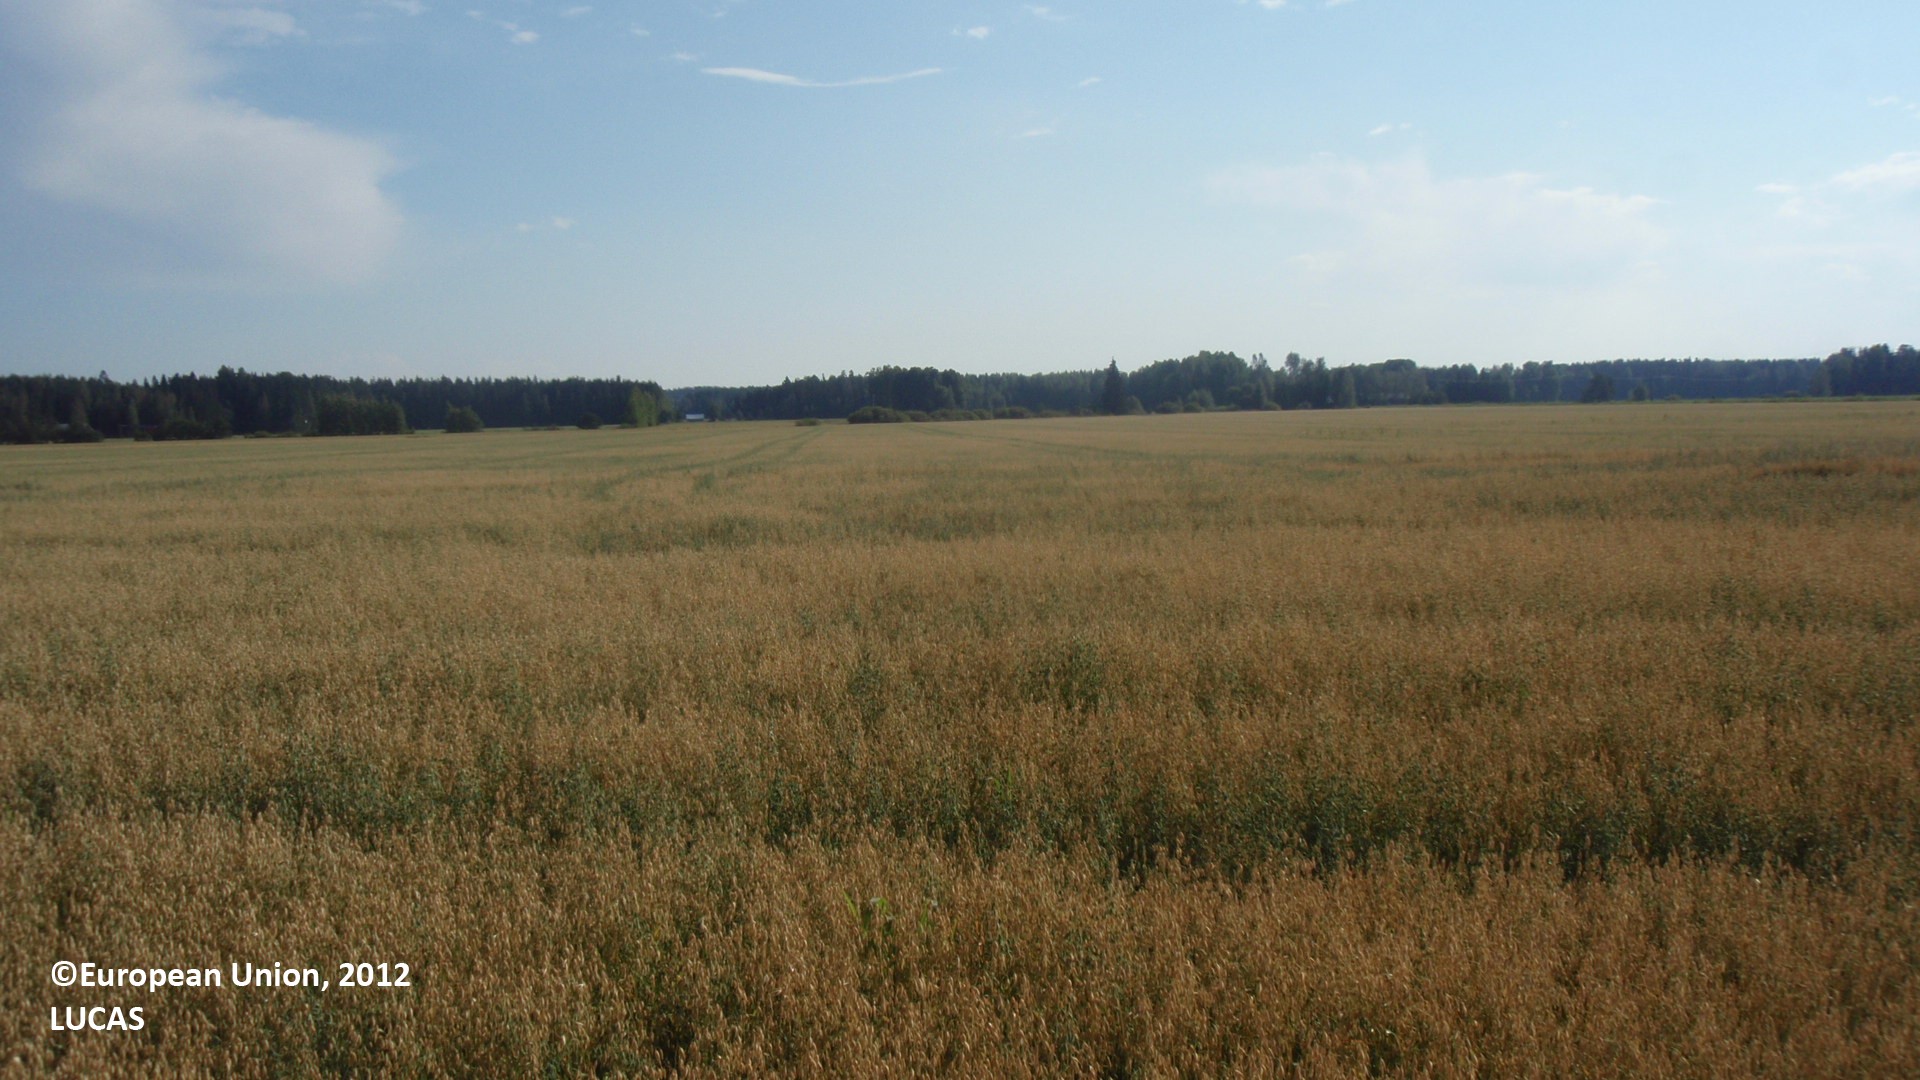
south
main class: Cropland
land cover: Oats
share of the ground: > 75 %
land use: Agriculture (excluding fallow land and kitchen gardens)
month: August
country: FI
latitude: 60.8104
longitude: 26.6080
